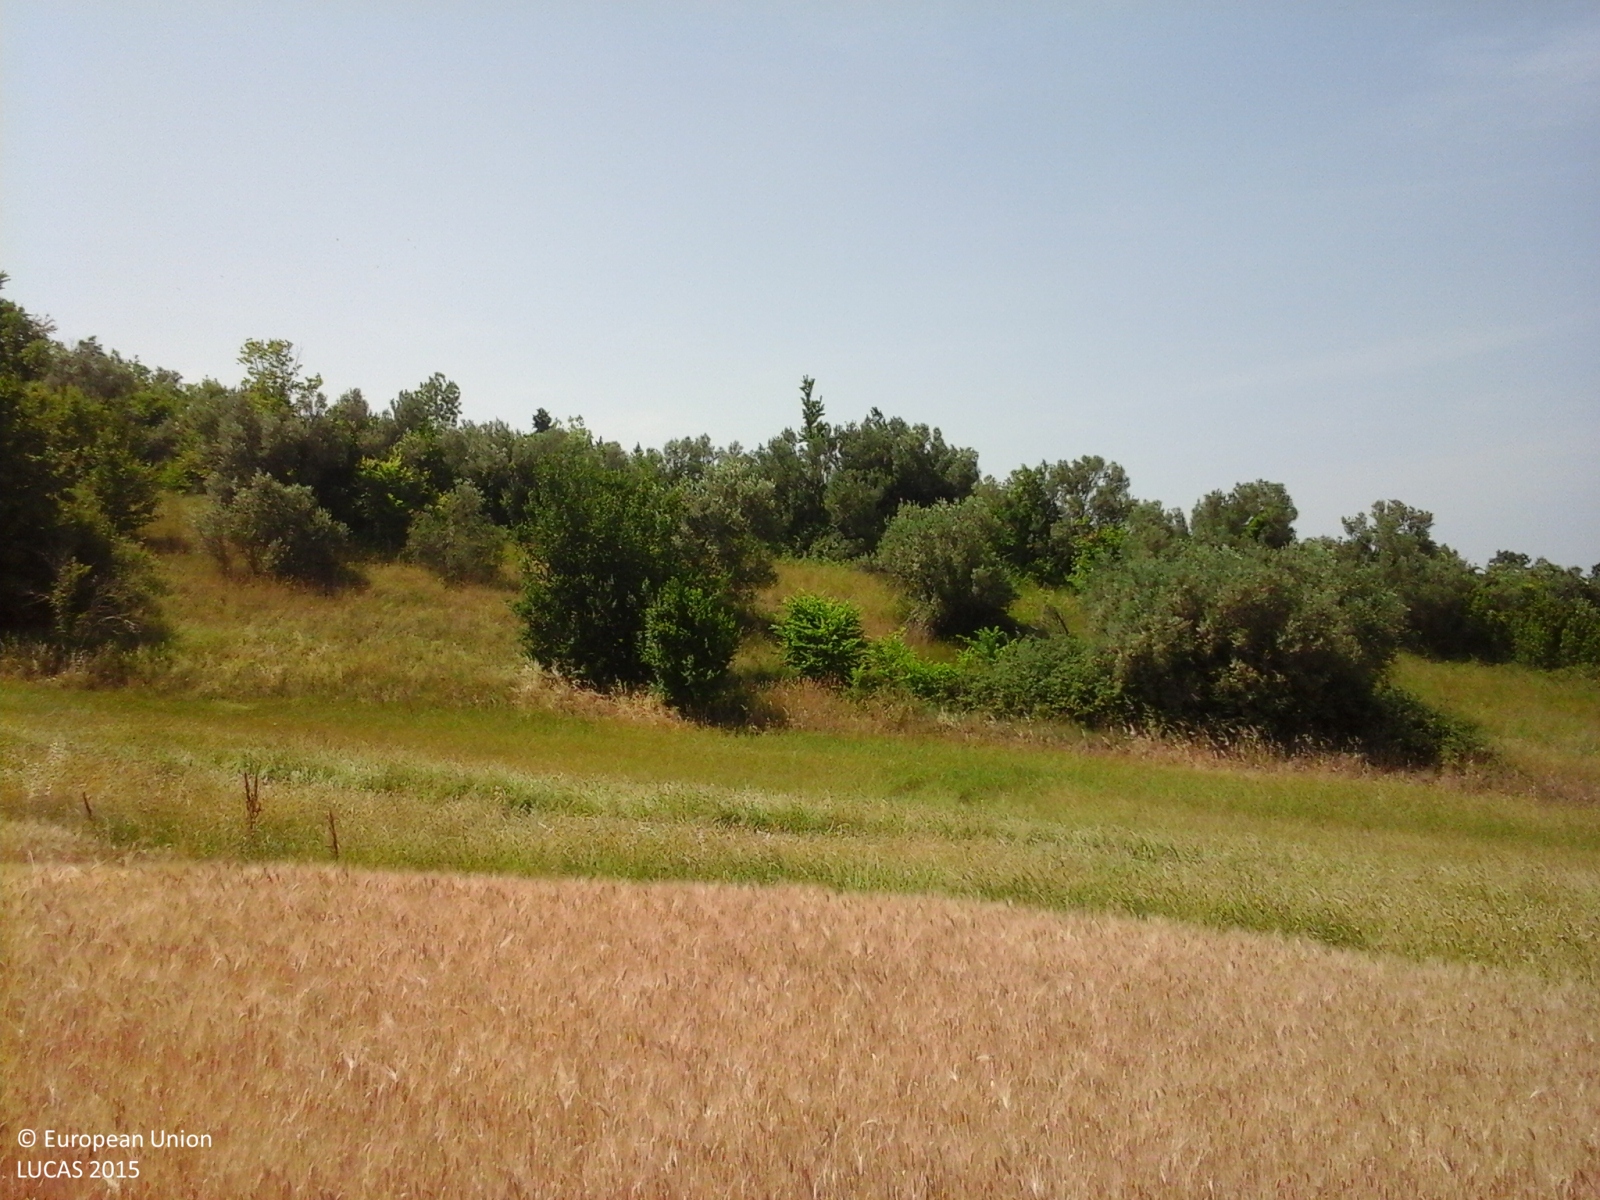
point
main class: Cropland
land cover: Olive groves
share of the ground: 25 - 50 %
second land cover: Spontaneously vegetated surfaces
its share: 25 - 50 %
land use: Agriculture (excluding fallow land and kitchen gardens)
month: June
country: IT
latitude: 42.1985
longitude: 14.3584
